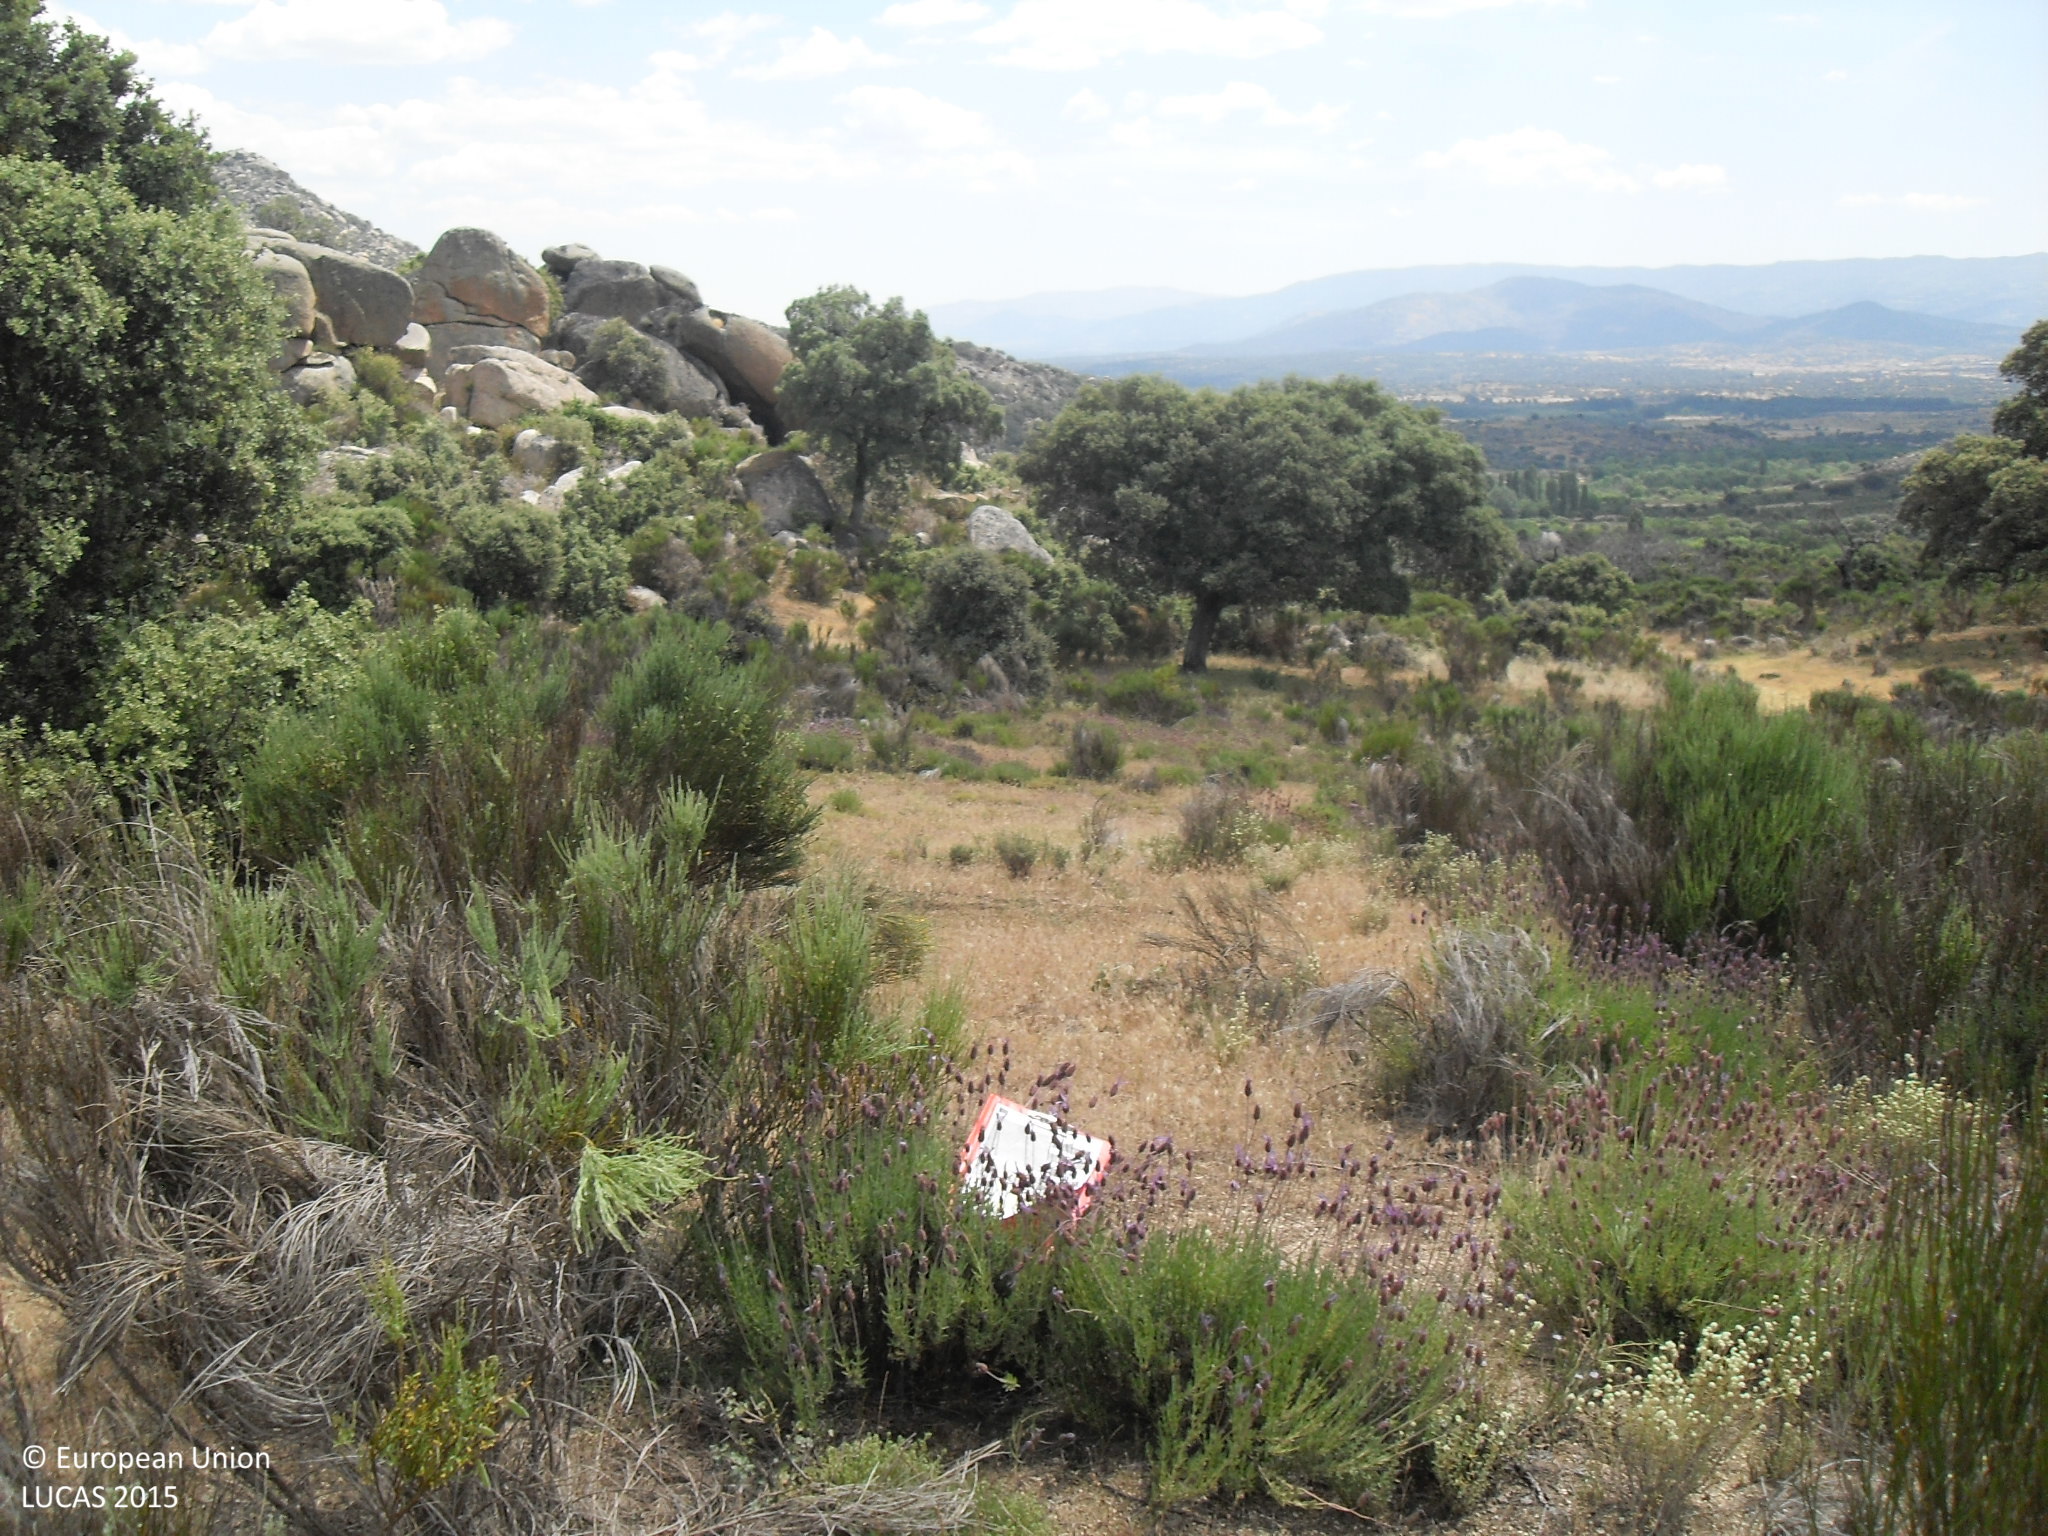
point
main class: Shrubland
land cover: Shrubland without tree cover
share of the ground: > 75 %
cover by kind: shrubs 60 %, herbaceous plants 40 %
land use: Abandoned areas
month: June
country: ES
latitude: 40.4491
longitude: -5.5729
